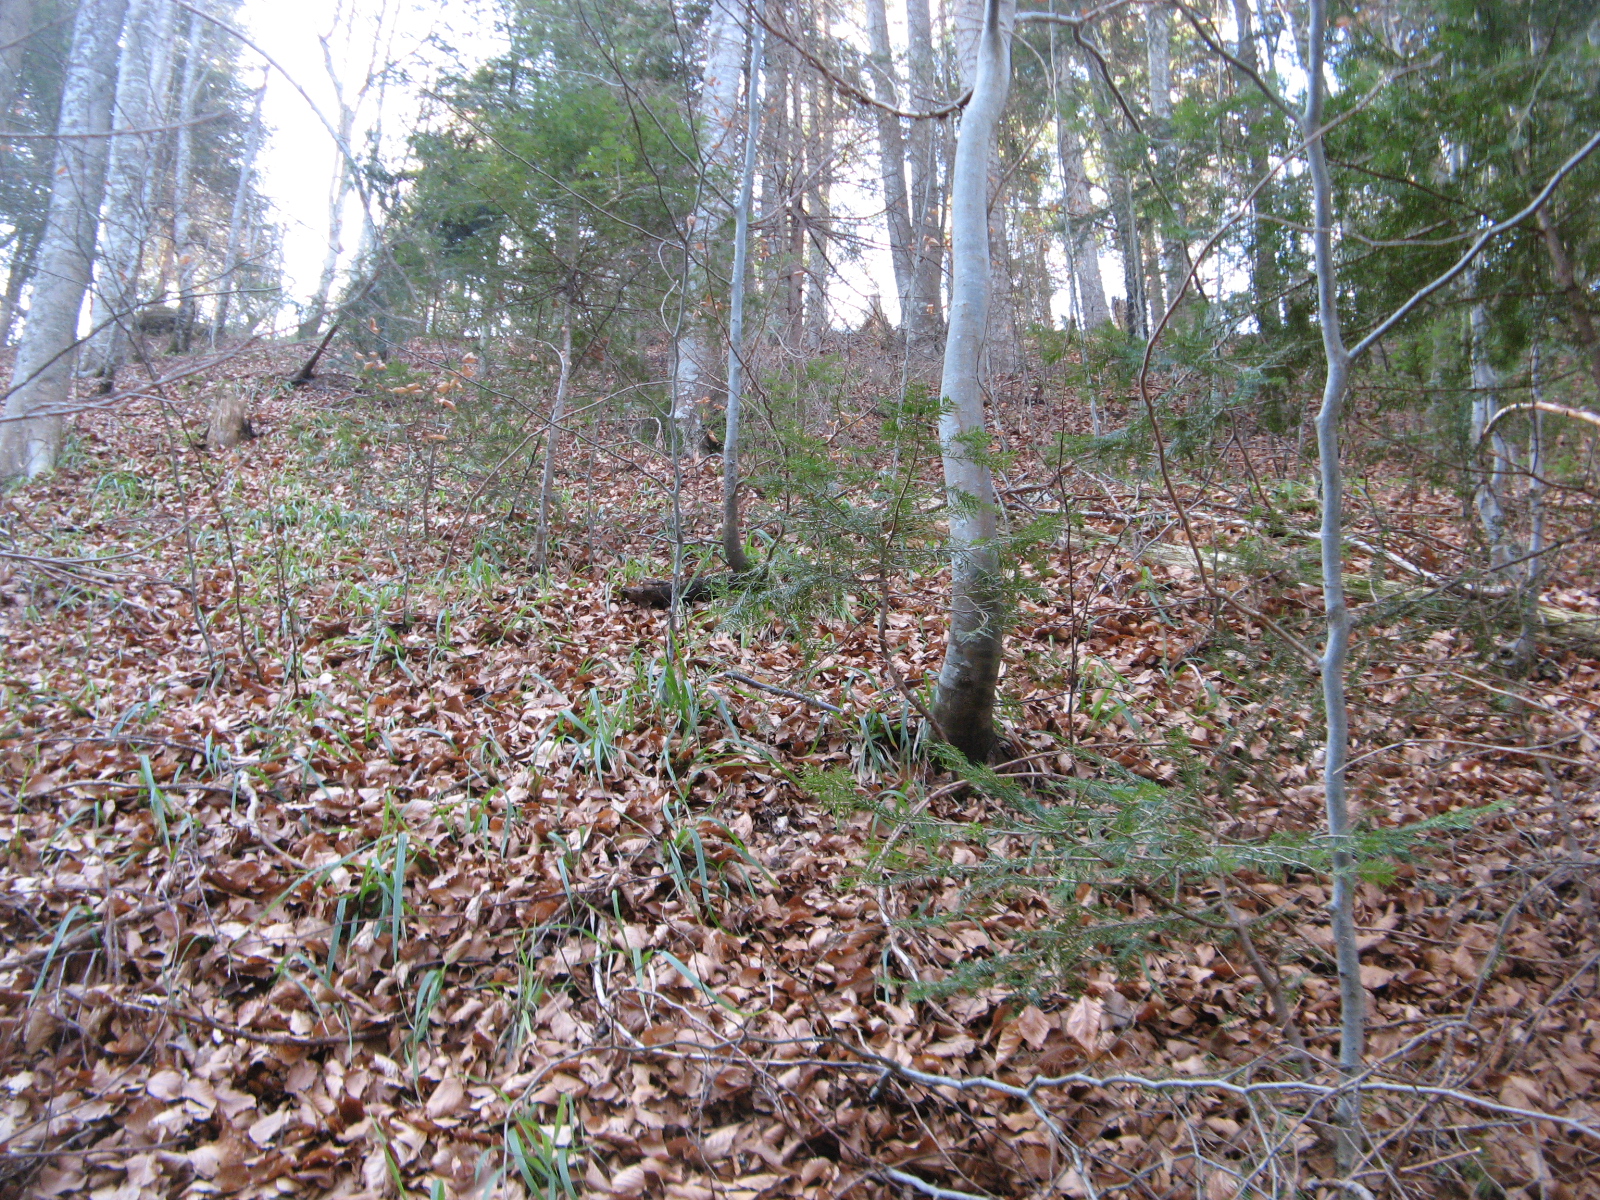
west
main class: Woodland
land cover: Other mixed woodland
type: hemiboreal forest and nemoral coniferous forest and mixed broadleaved-coniferous forest
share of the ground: > 75 %
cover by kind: broadleaved forest trees 45 %, coniferous forest trees 40 %, unconsolidated bare surface 10 %, herbaceous plants 5 %
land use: Forestry
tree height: > 5 m
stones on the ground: < 10 %
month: December
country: BG
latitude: 41.9526
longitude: 24.1170
